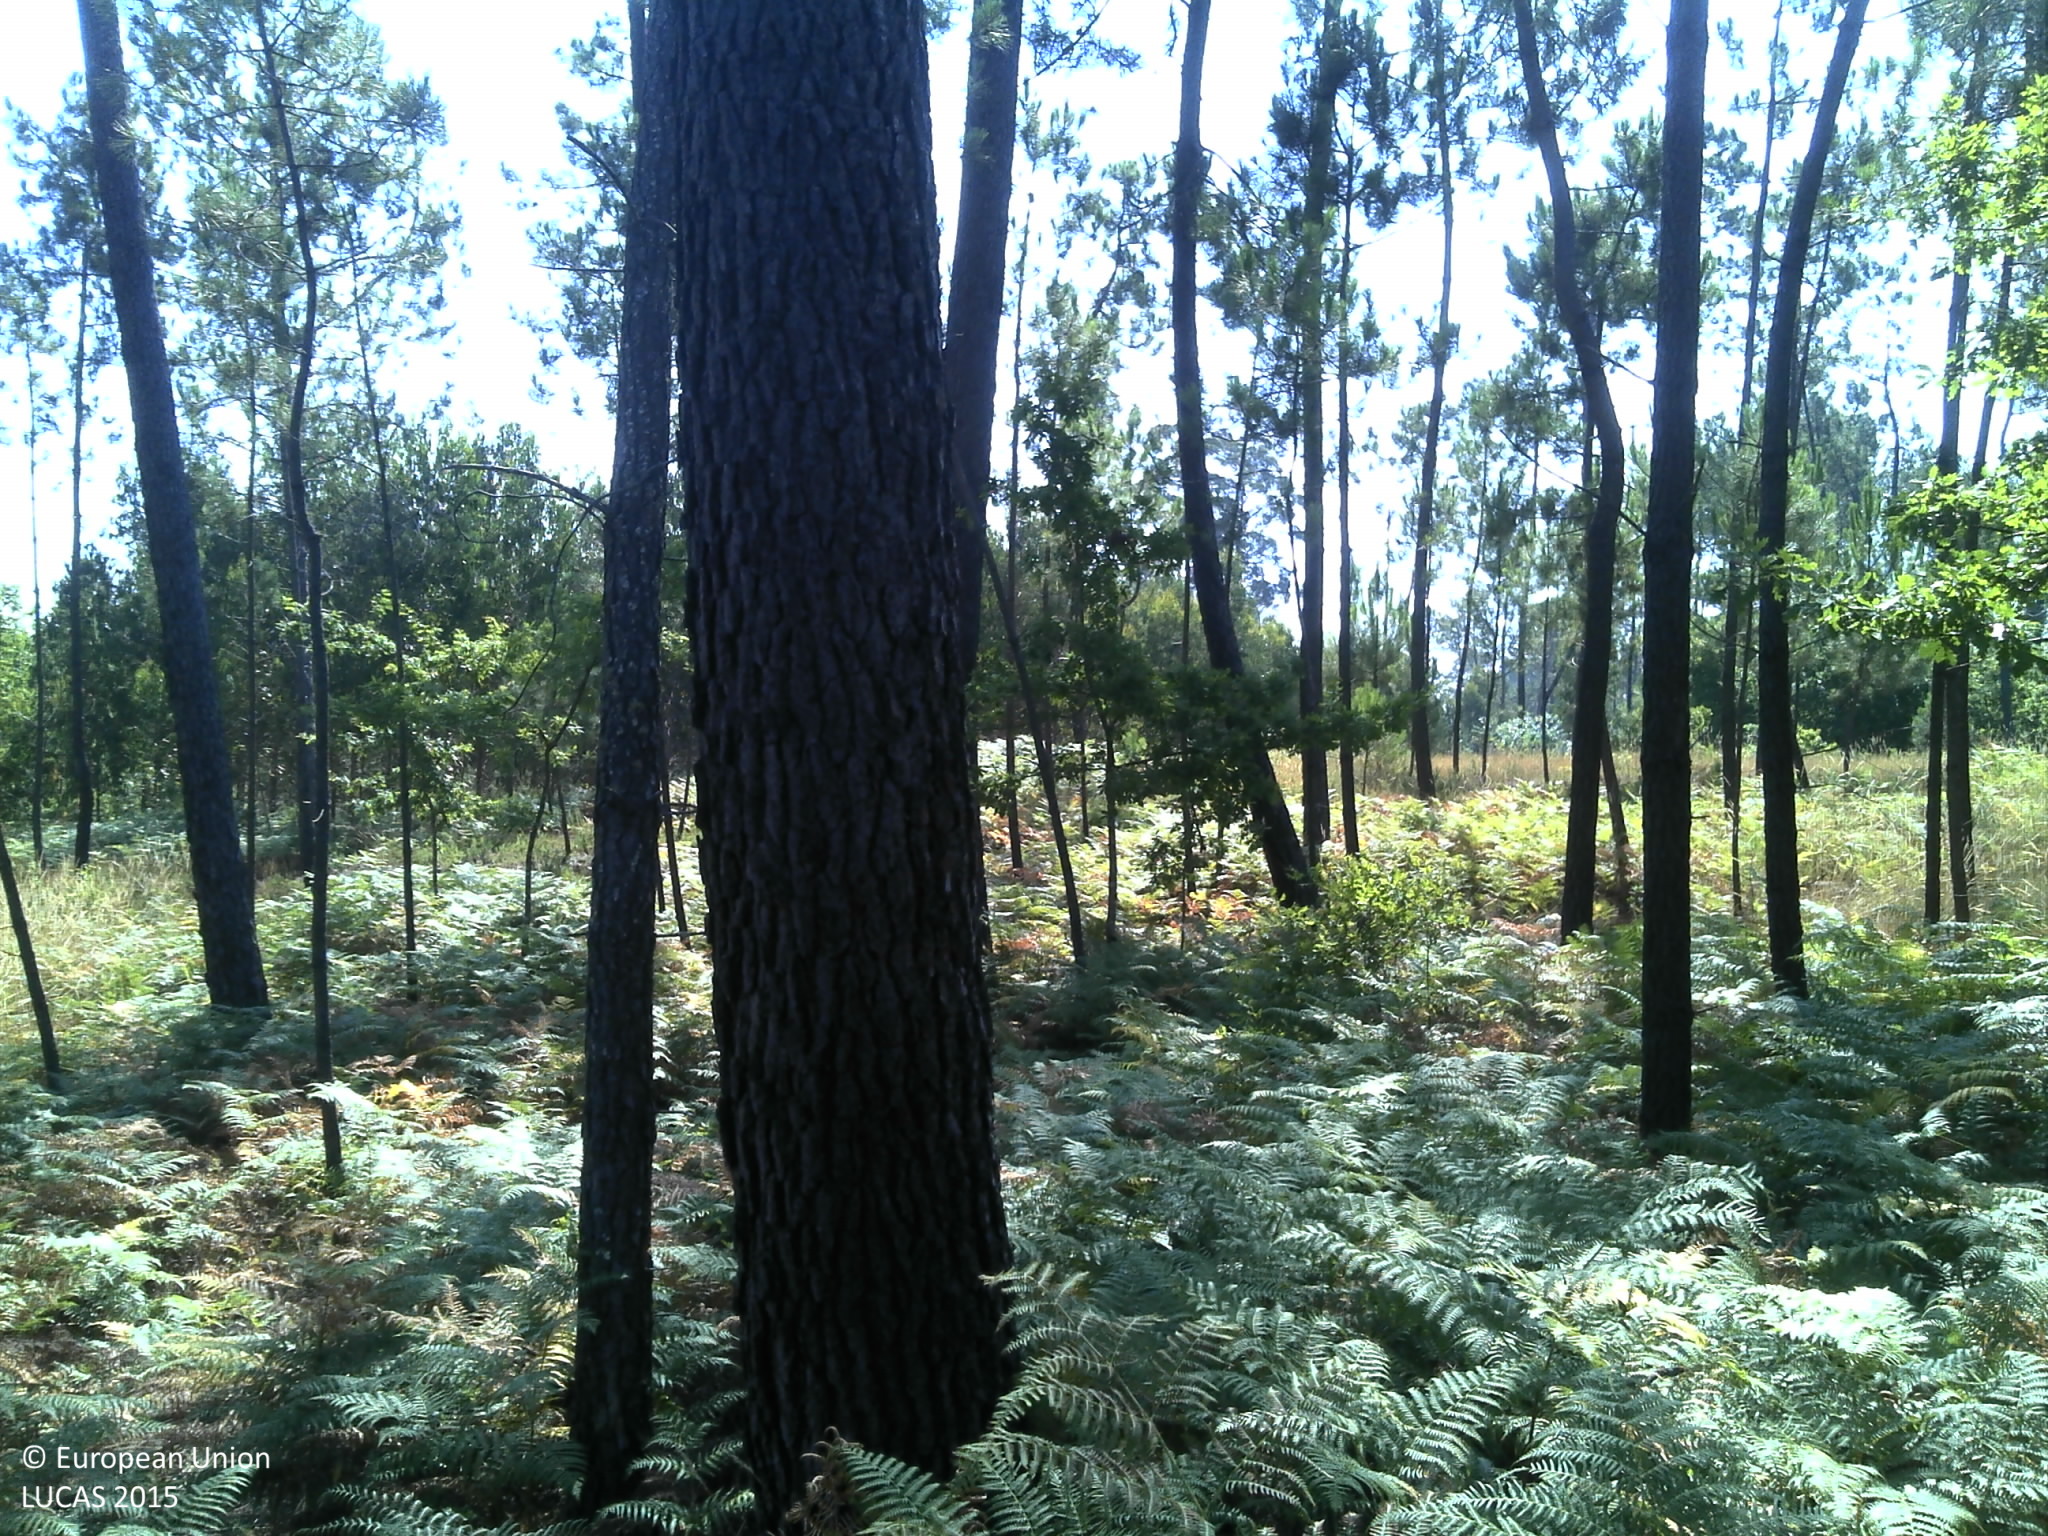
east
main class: Woodland
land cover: Pine dominated coniferous woodland
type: coniferous forest of the mediterranean region
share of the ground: 50 - 75 %
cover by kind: coniferous forest trees 60 %, shrubs 15 %, consolidated bare surface 10 %, unconsolidated bare surface 10 %, herbaceous plants 5 %
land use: Forestry
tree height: > 5 m
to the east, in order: Pine dominated coniferous woodland; Shrubland with sparse tree cover; Broadleaved woodland; Tracks; Pine dominated coniferous woodland; Shrubland with sparse tree cover; Broadleaved woodland
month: July
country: PT
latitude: 40.4294
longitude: -8.0286
